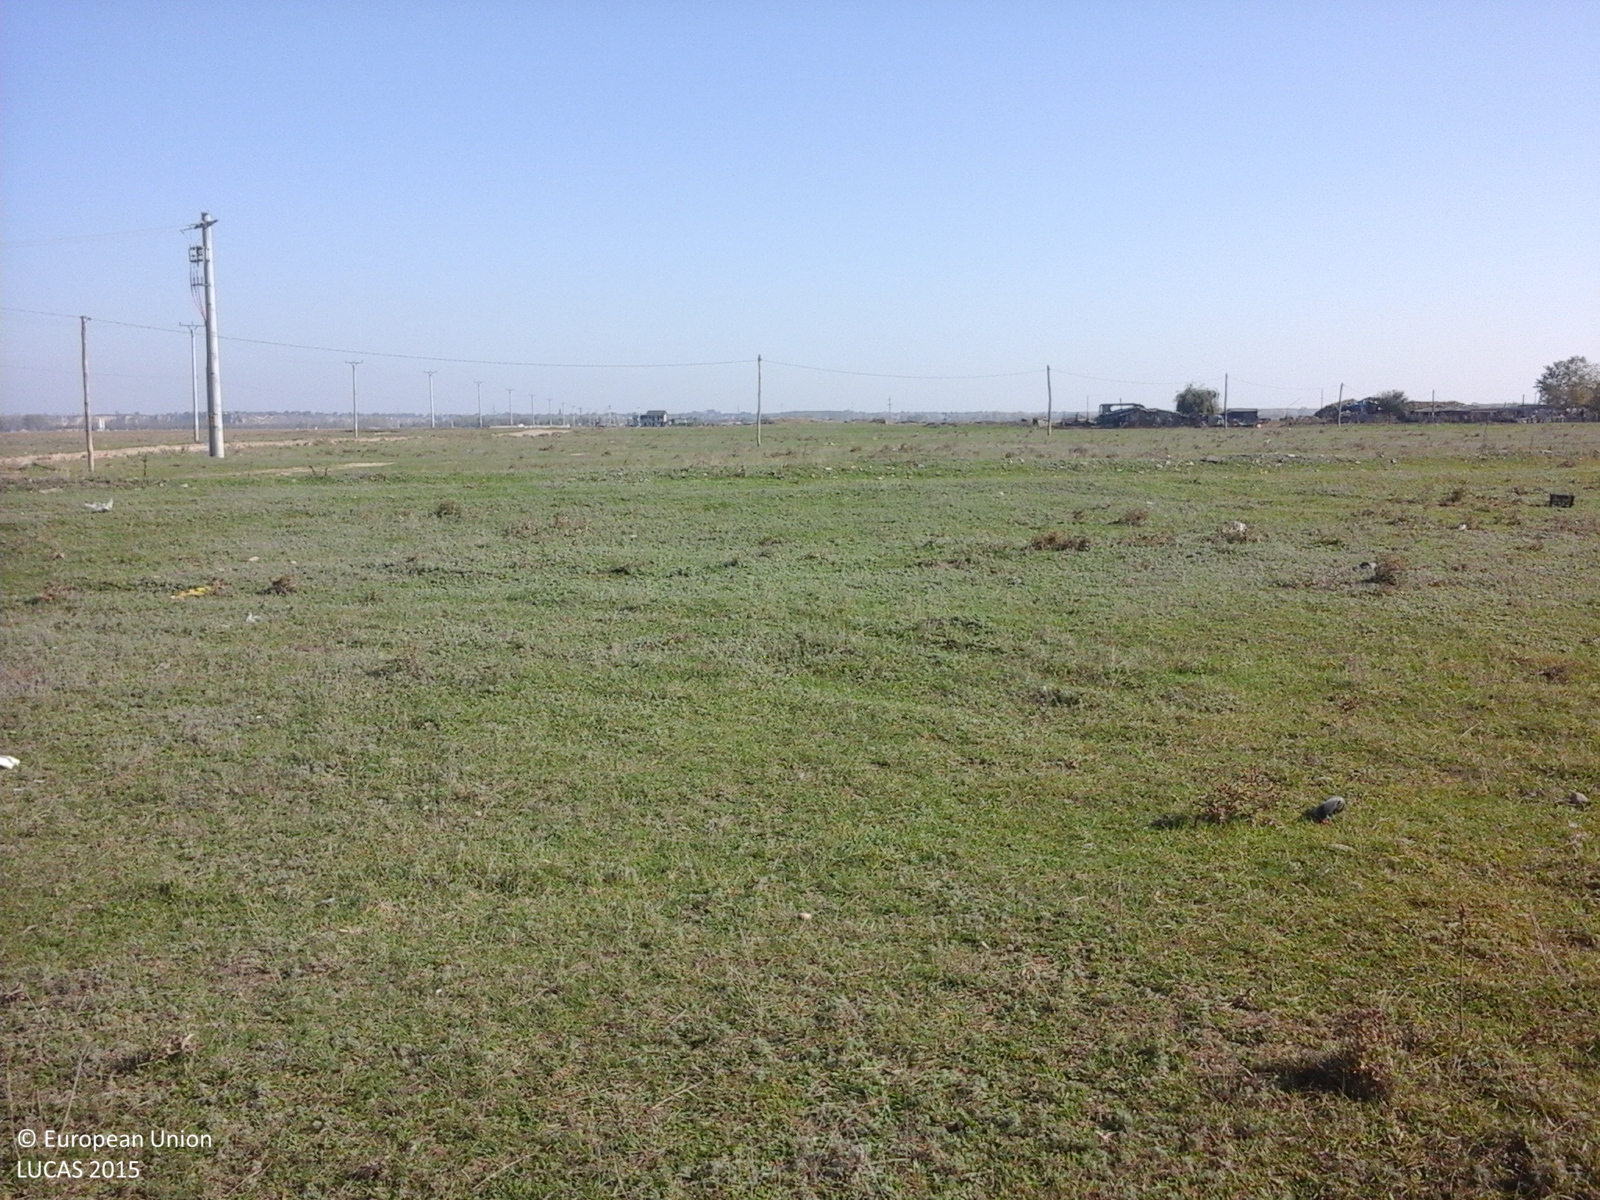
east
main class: Grassland
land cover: Grassland without tree/shrub cover
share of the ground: > 75 %
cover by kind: herbaceous plants 100 %
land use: Agriculture (excluding fallow land and kitchen gardens)
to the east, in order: Grassland without tree/shrub cover; Ditches and canals; Grass margins; Tracks; Grassland without tree/shrub cover; Electric lines; Grassland without tree/shrub cover; Tracks; Grassland without tree/shrub cover; Paved roads, cycling and walking lanes; Grassland without tree/shrub cover; Tracks; Grassland without tree/shrub cover
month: October
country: RO
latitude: 45.8752
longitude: 27.2460
